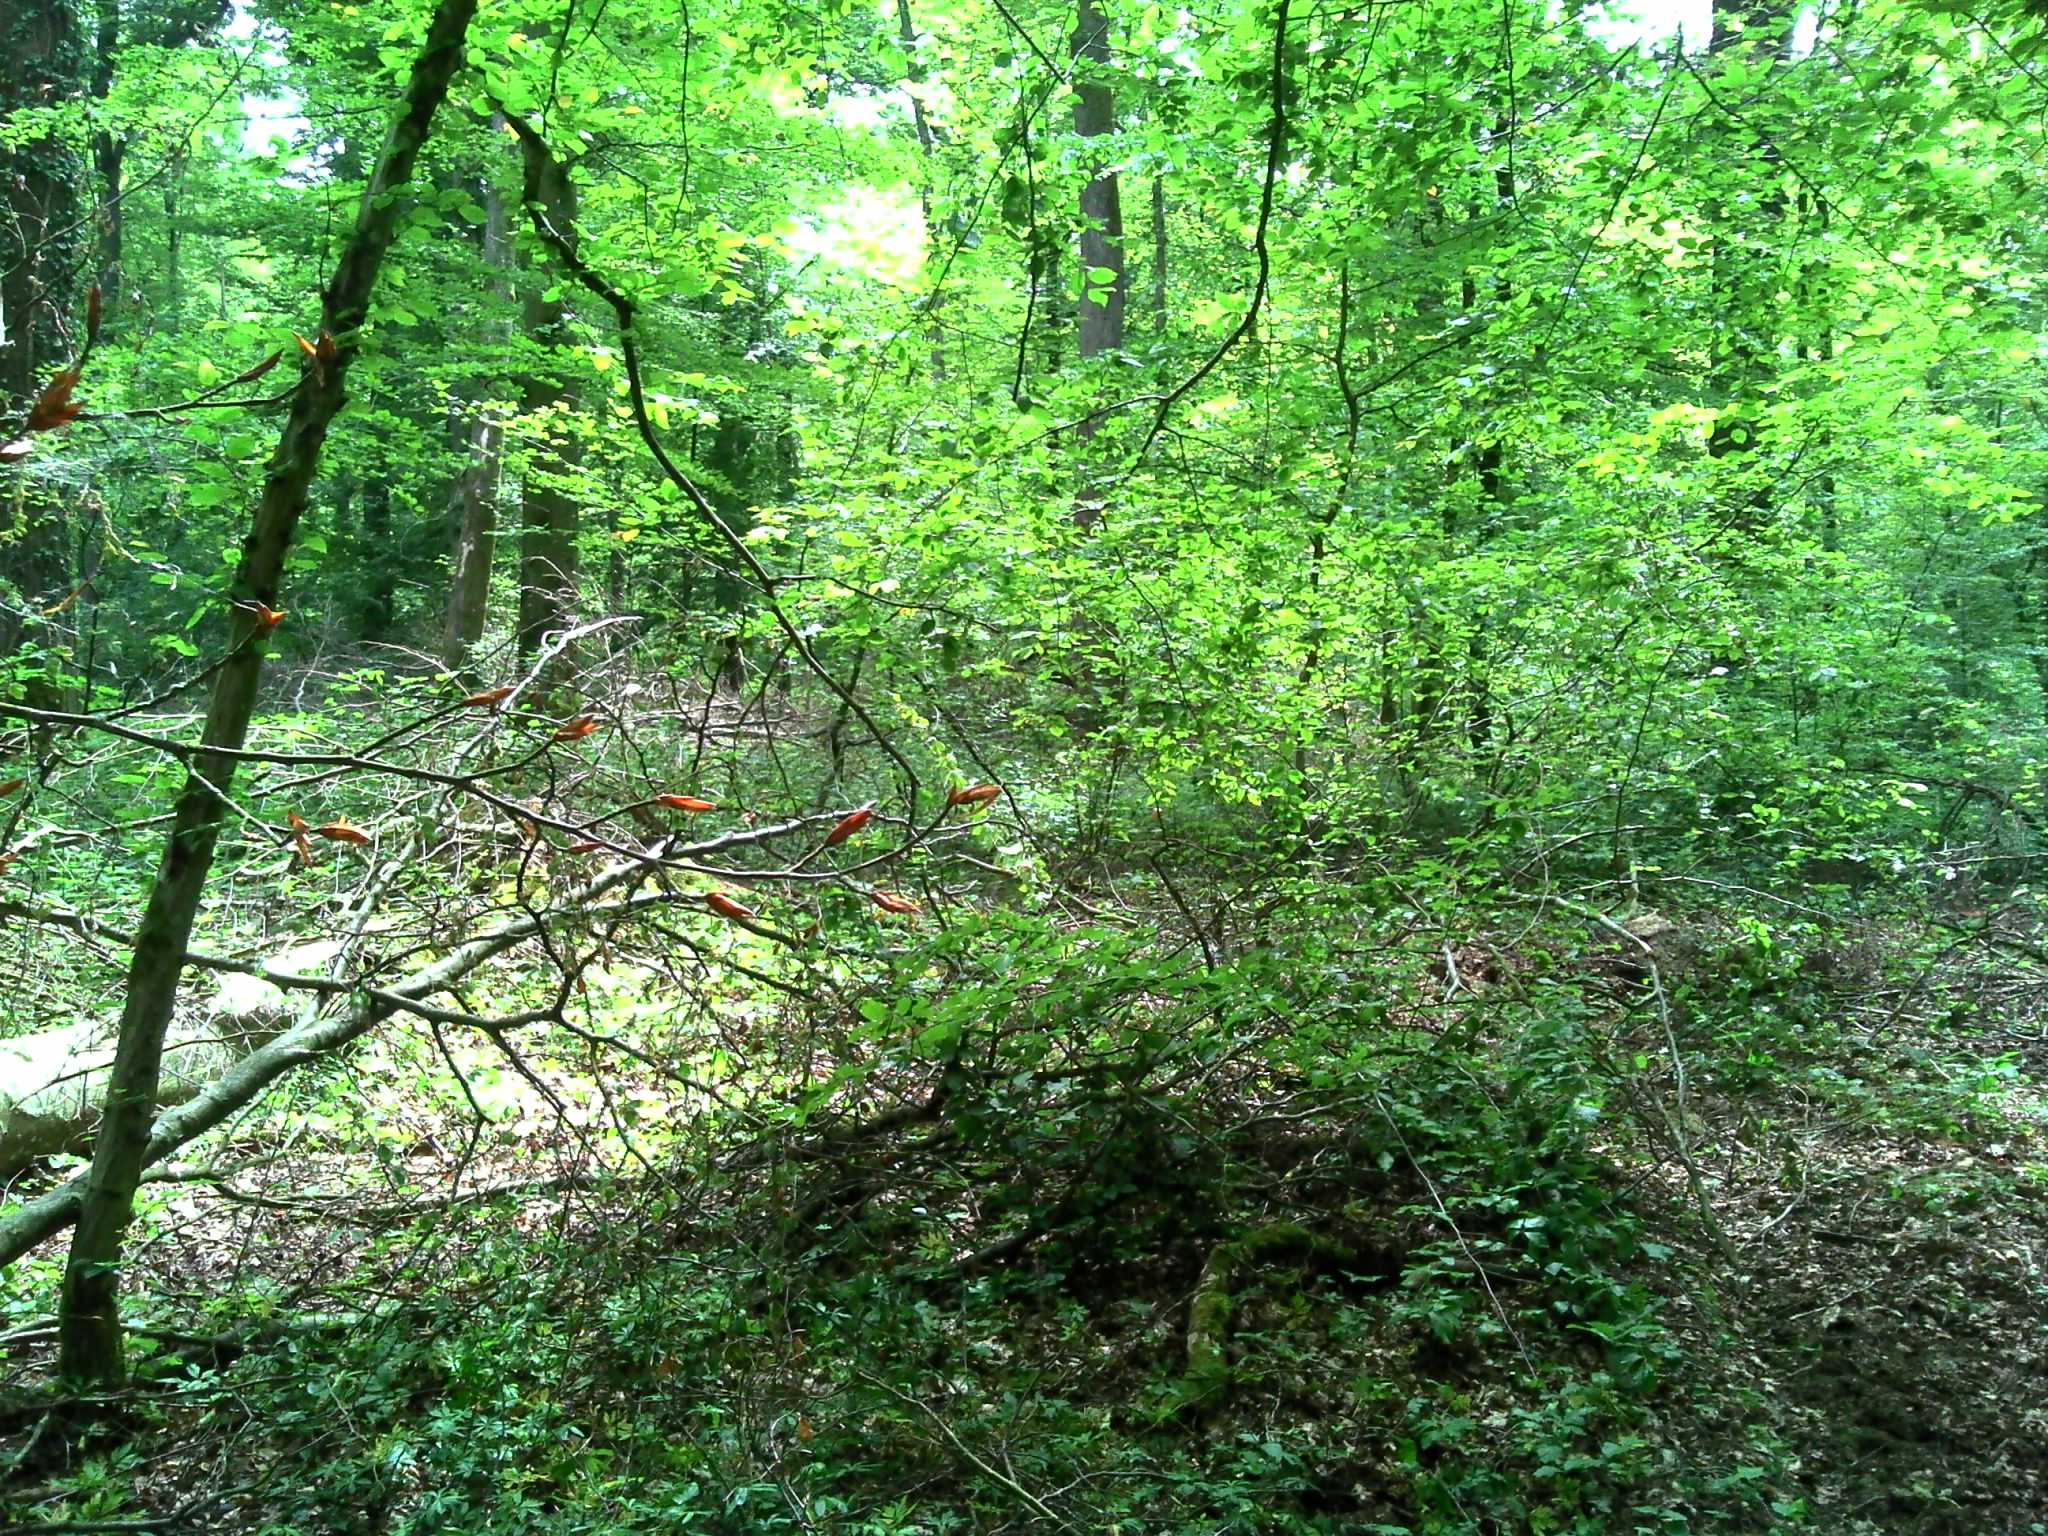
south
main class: Woodland
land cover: Broadleaved woodland
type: beech forest
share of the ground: > 75 %
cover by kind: broadleaved forest trees 80 %, herbaceous plants 15 %, consolidated bare surface 5 %
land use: Forestry
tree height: > 5 m
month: June
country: LU
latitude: 49.6239
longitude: 5.8877
